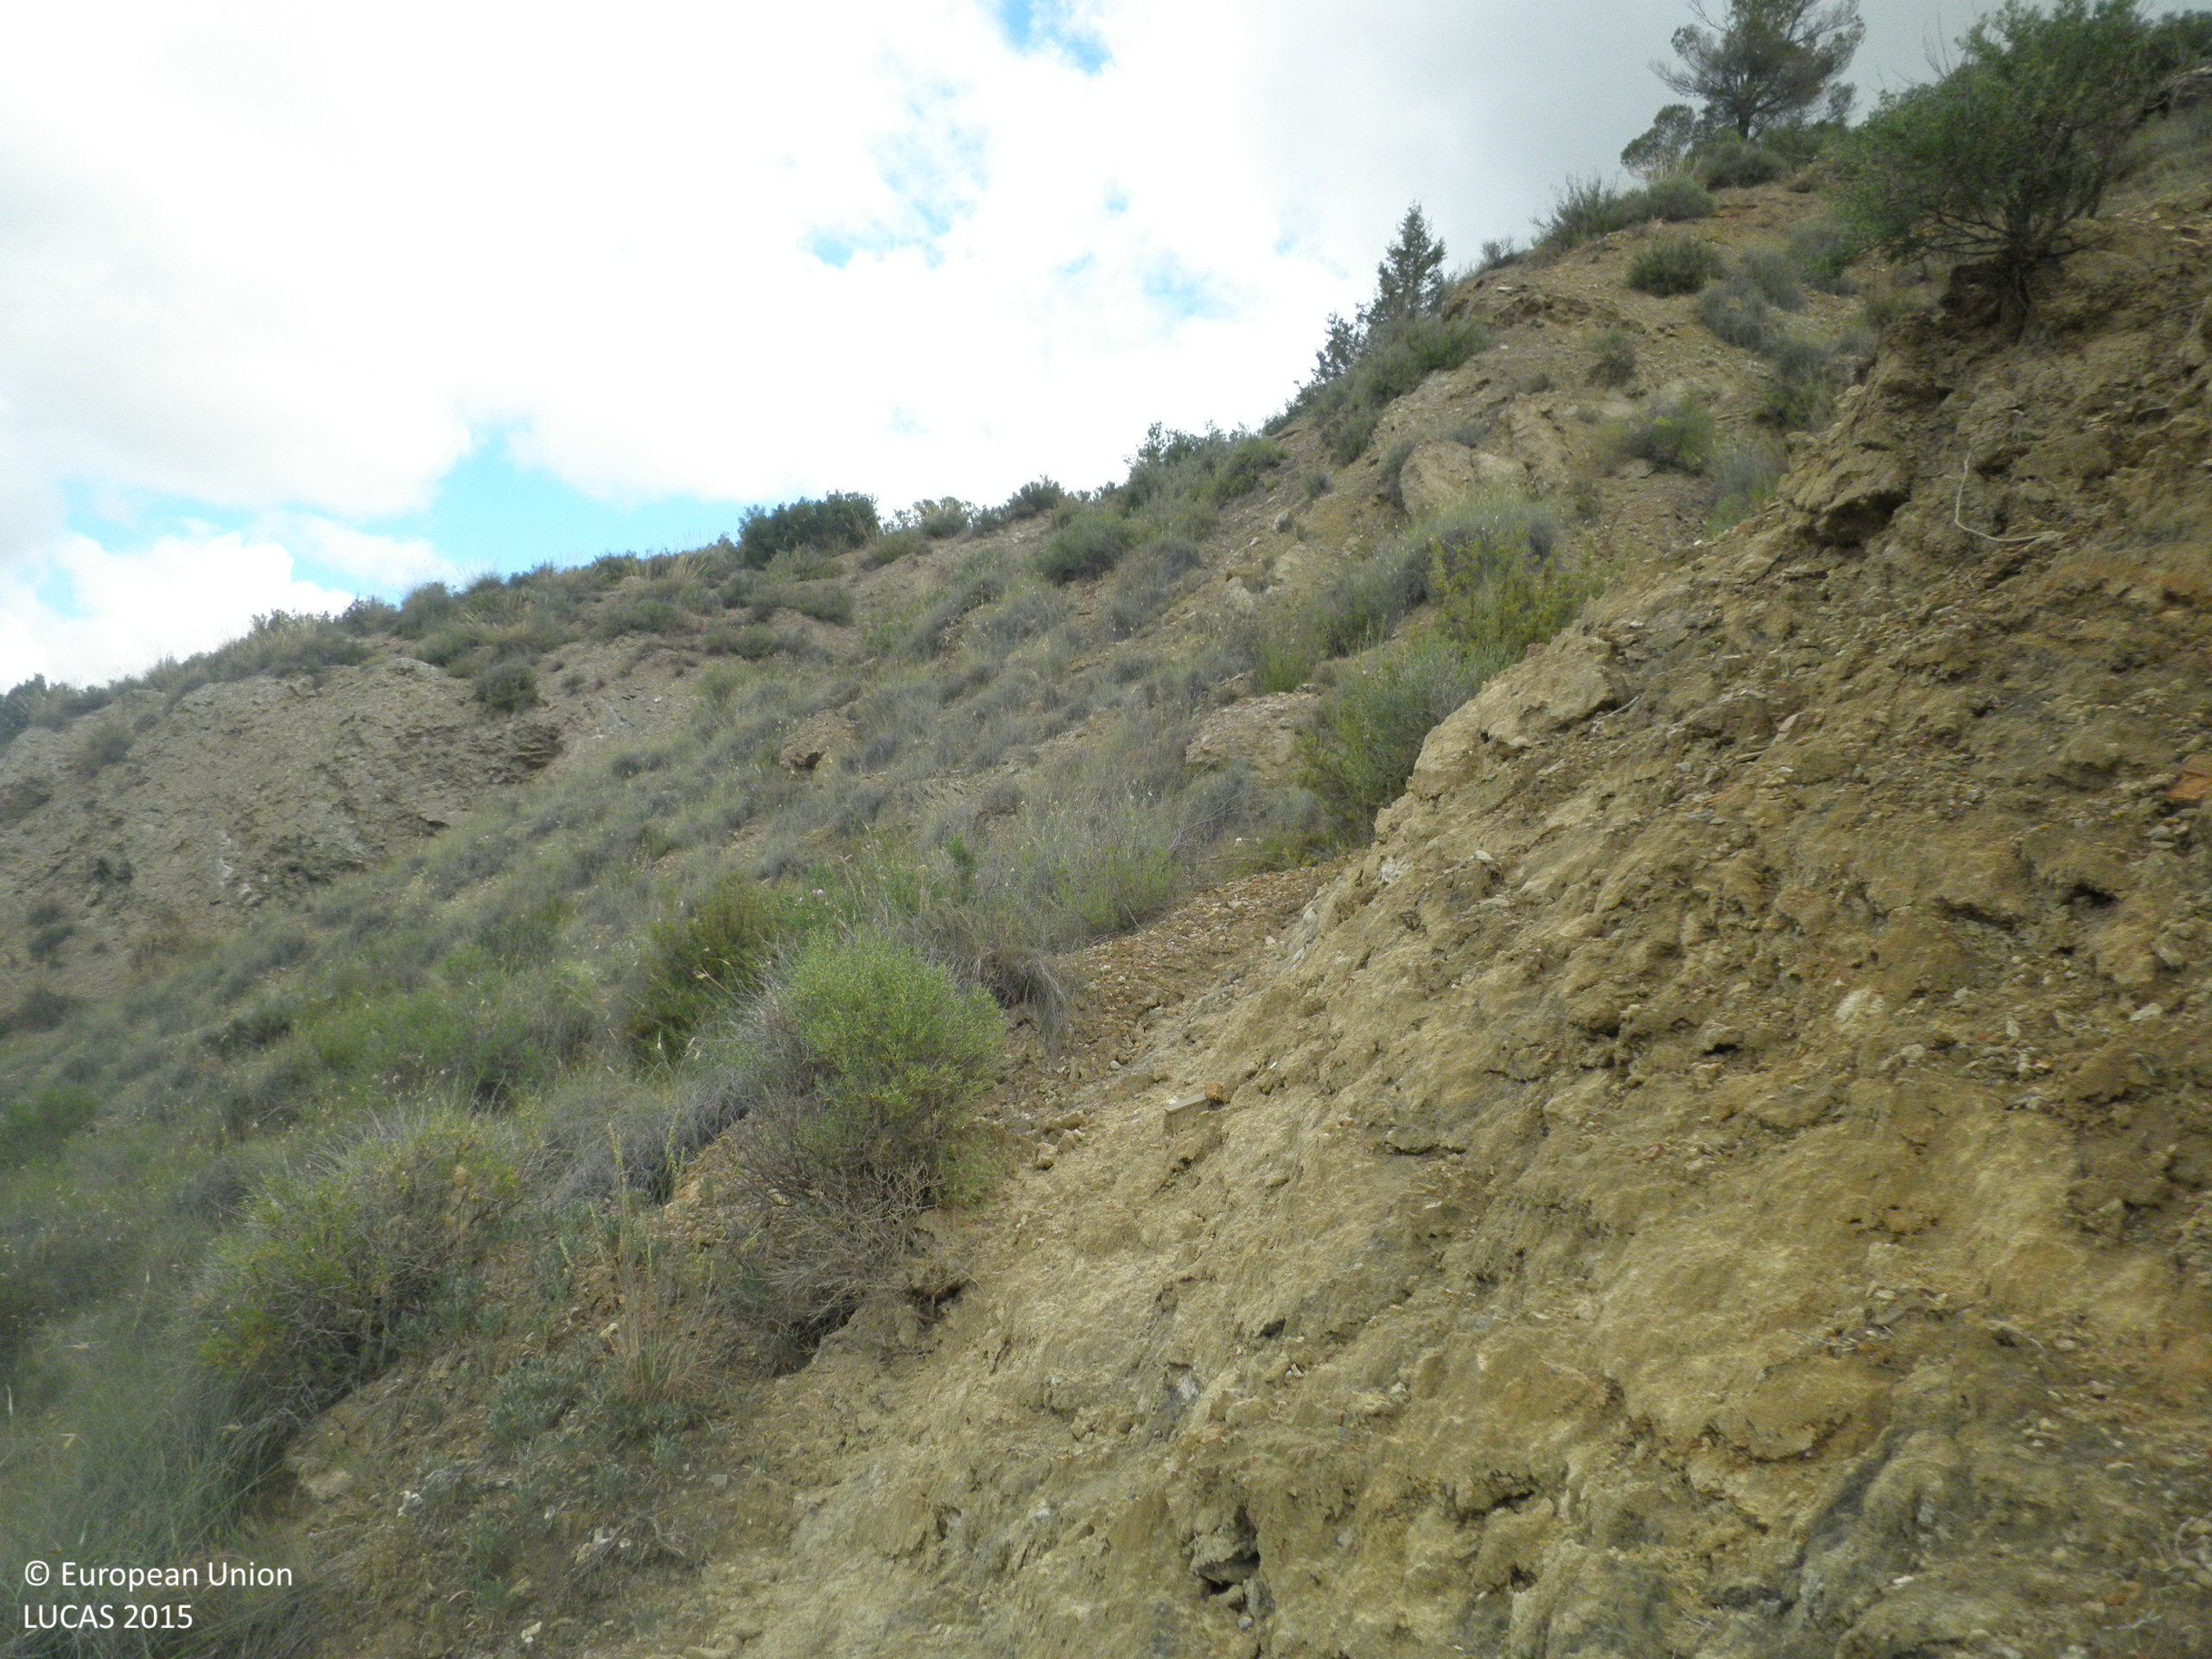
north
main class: Shrubland
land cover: Shrubland without tree cover
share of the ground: 10 - 25 %
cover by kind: unconsolidated bare surface 80 %, shrubs 20 %
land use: Semi-natural and natural areas not in use
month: June
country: ES
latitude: 39.7445
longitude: -1.5722
